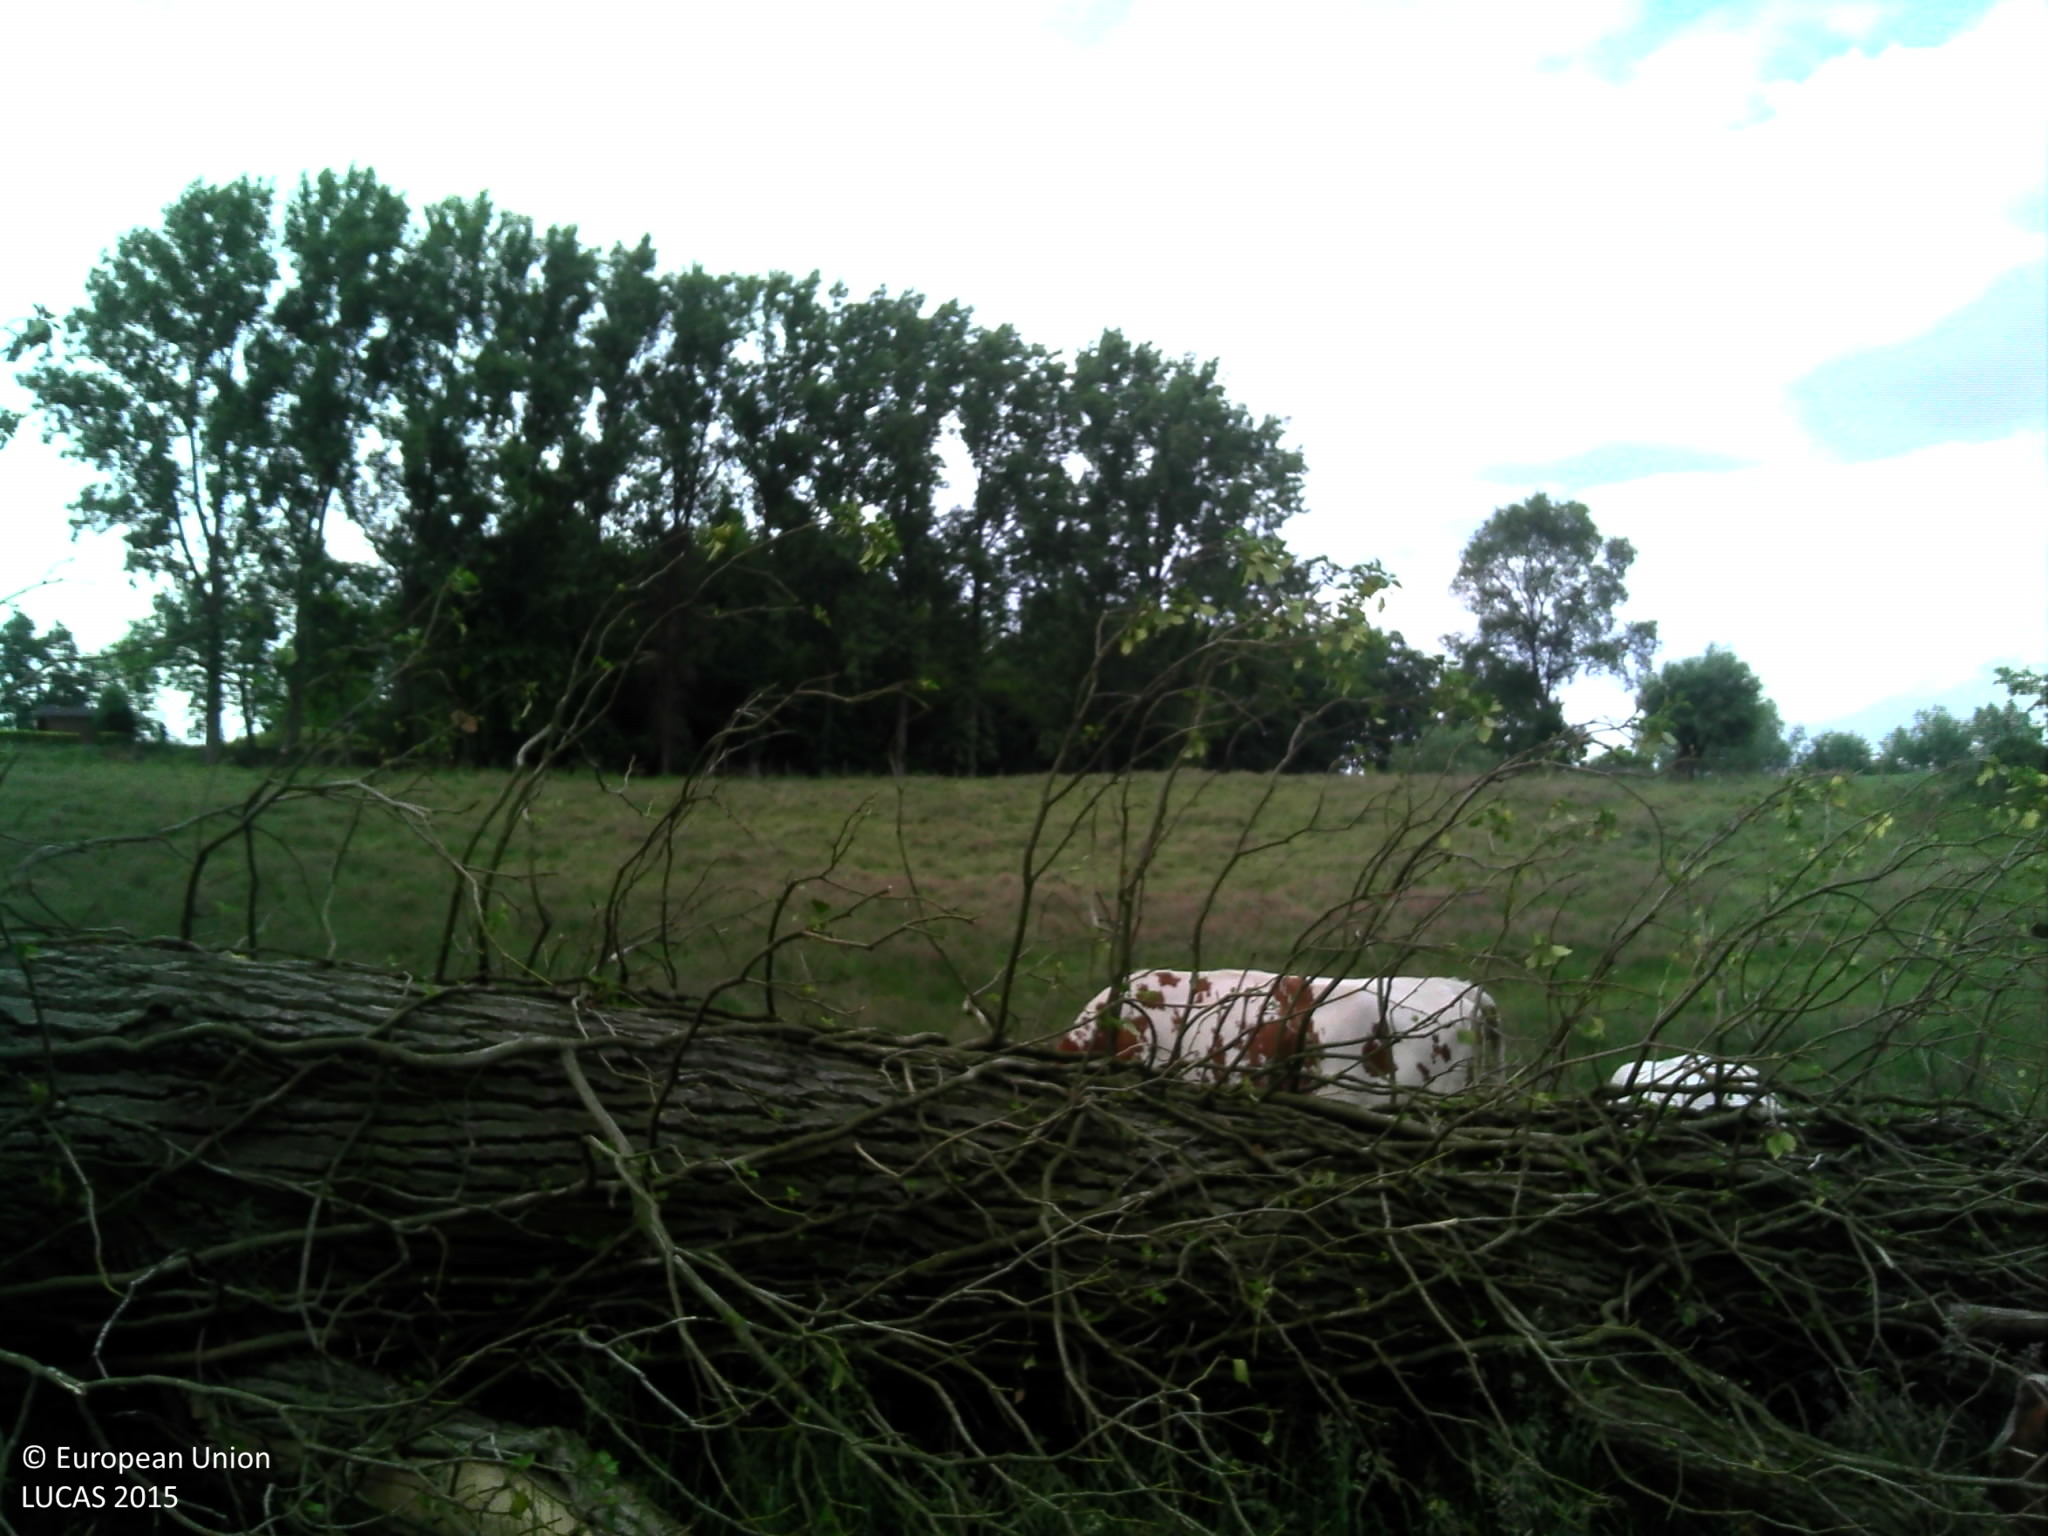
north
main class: Grassland
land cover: Grassland without tree/shrub cover
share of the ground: > 75 %
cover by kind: herbaceous plants 100 %
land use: Agriculture (excluding fallow land and kitchen gardens)
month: June
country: BE
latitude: 50.7788
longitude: 3.9097
